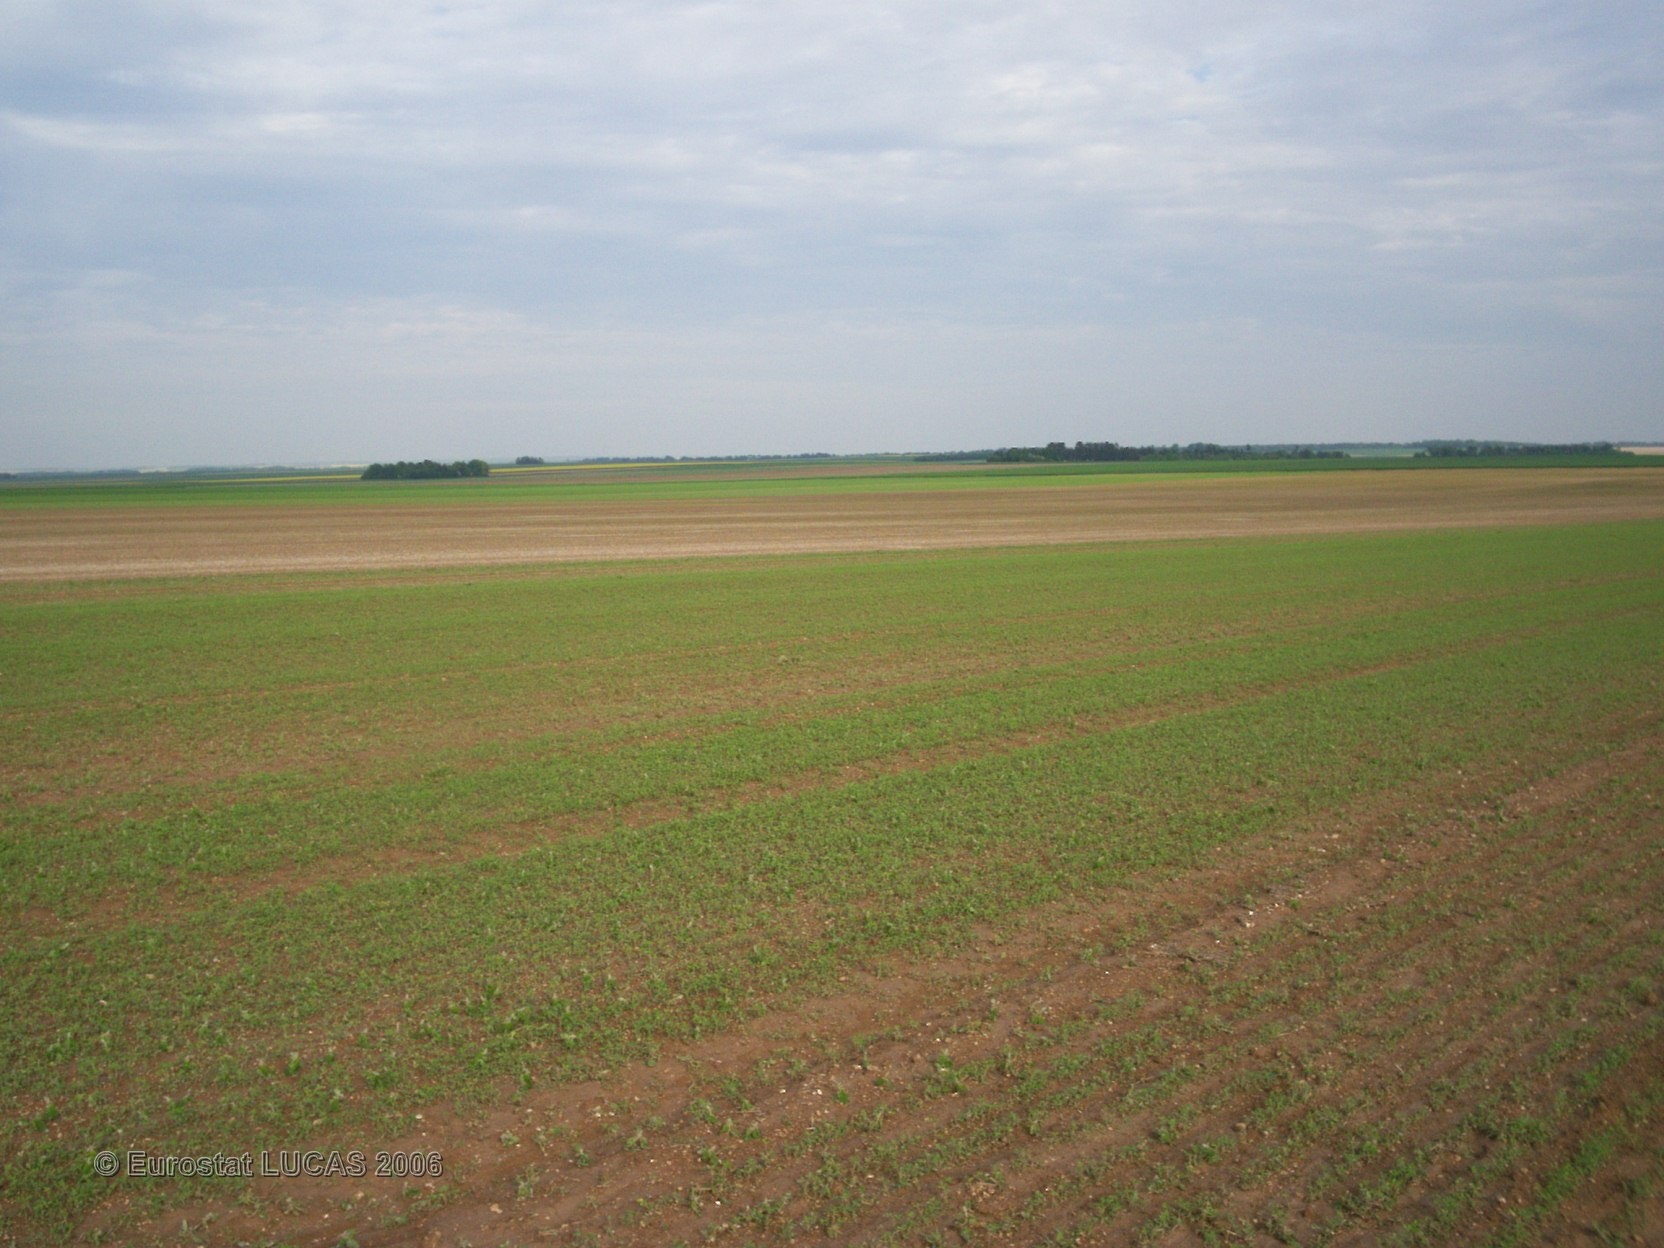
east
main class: Cropland
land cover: Lucerne
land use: Agriculture (excluding fallow land and kitchen gardens)
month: May
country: FR
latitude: 49.1792
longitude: 4.3579
